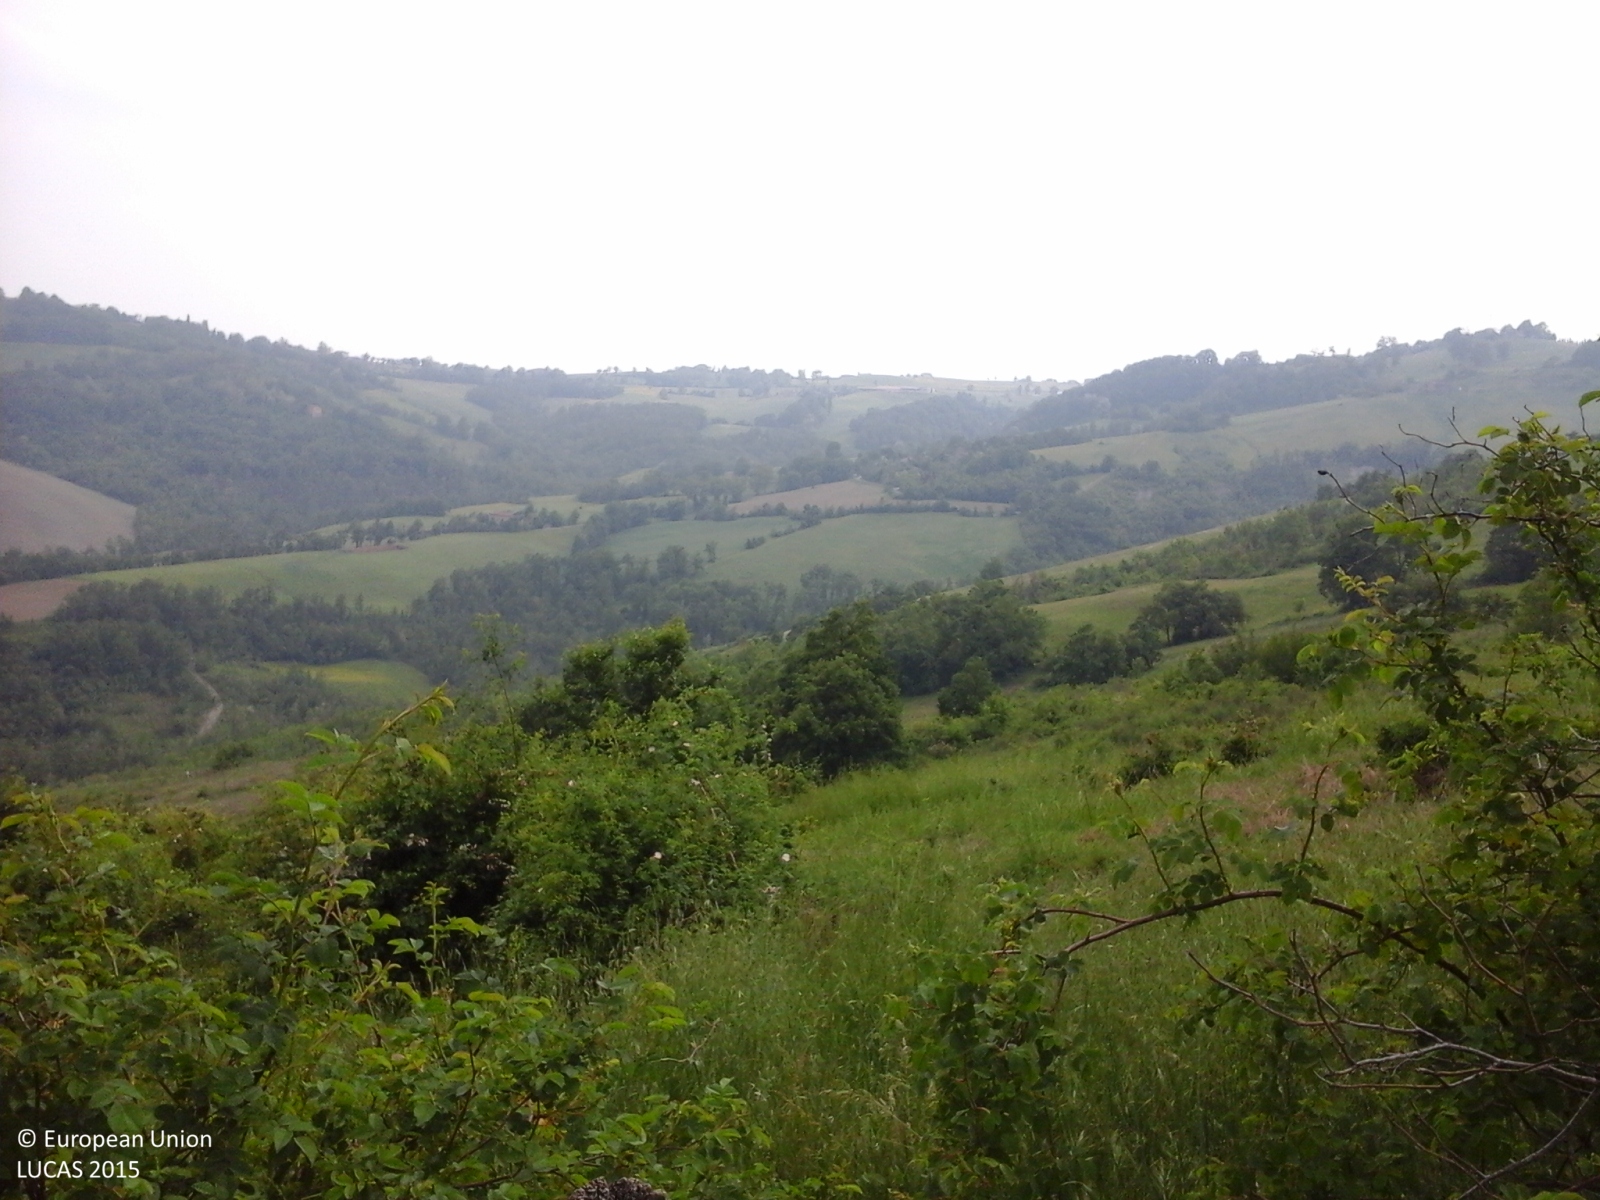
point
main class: Woodland
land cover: Broadleaved woodland
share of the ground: 50 - 75 %
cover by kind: broadleaved forest trees 60 %, herbaceous plants 30 %, shrubs 10 %
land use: Amenities, museums, leisure
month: May
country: IT
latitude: 44.4549
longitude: 10.8903
